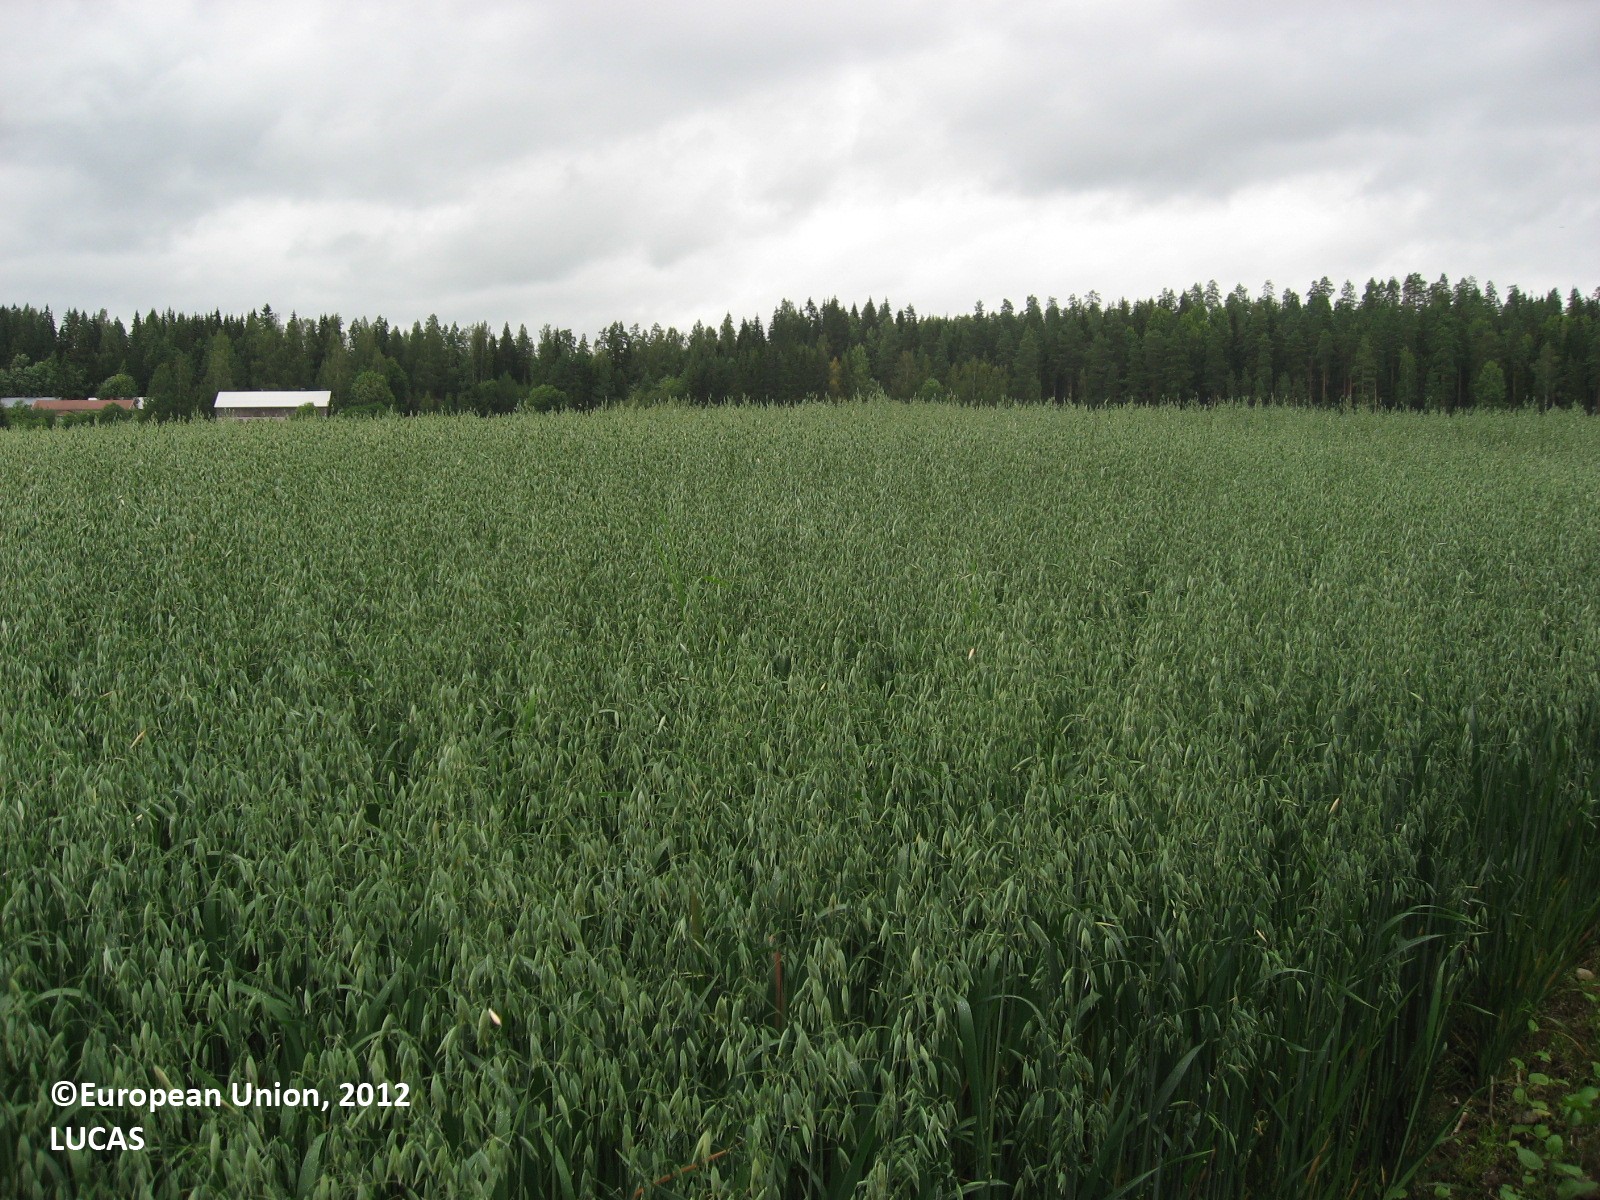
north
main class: Cropland
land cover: Oats
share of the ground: > 75 %
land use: Agriculture (excluding fallow land and kitchen gardens)
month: August
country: FI
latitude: 60.6191
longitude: 25.5330
